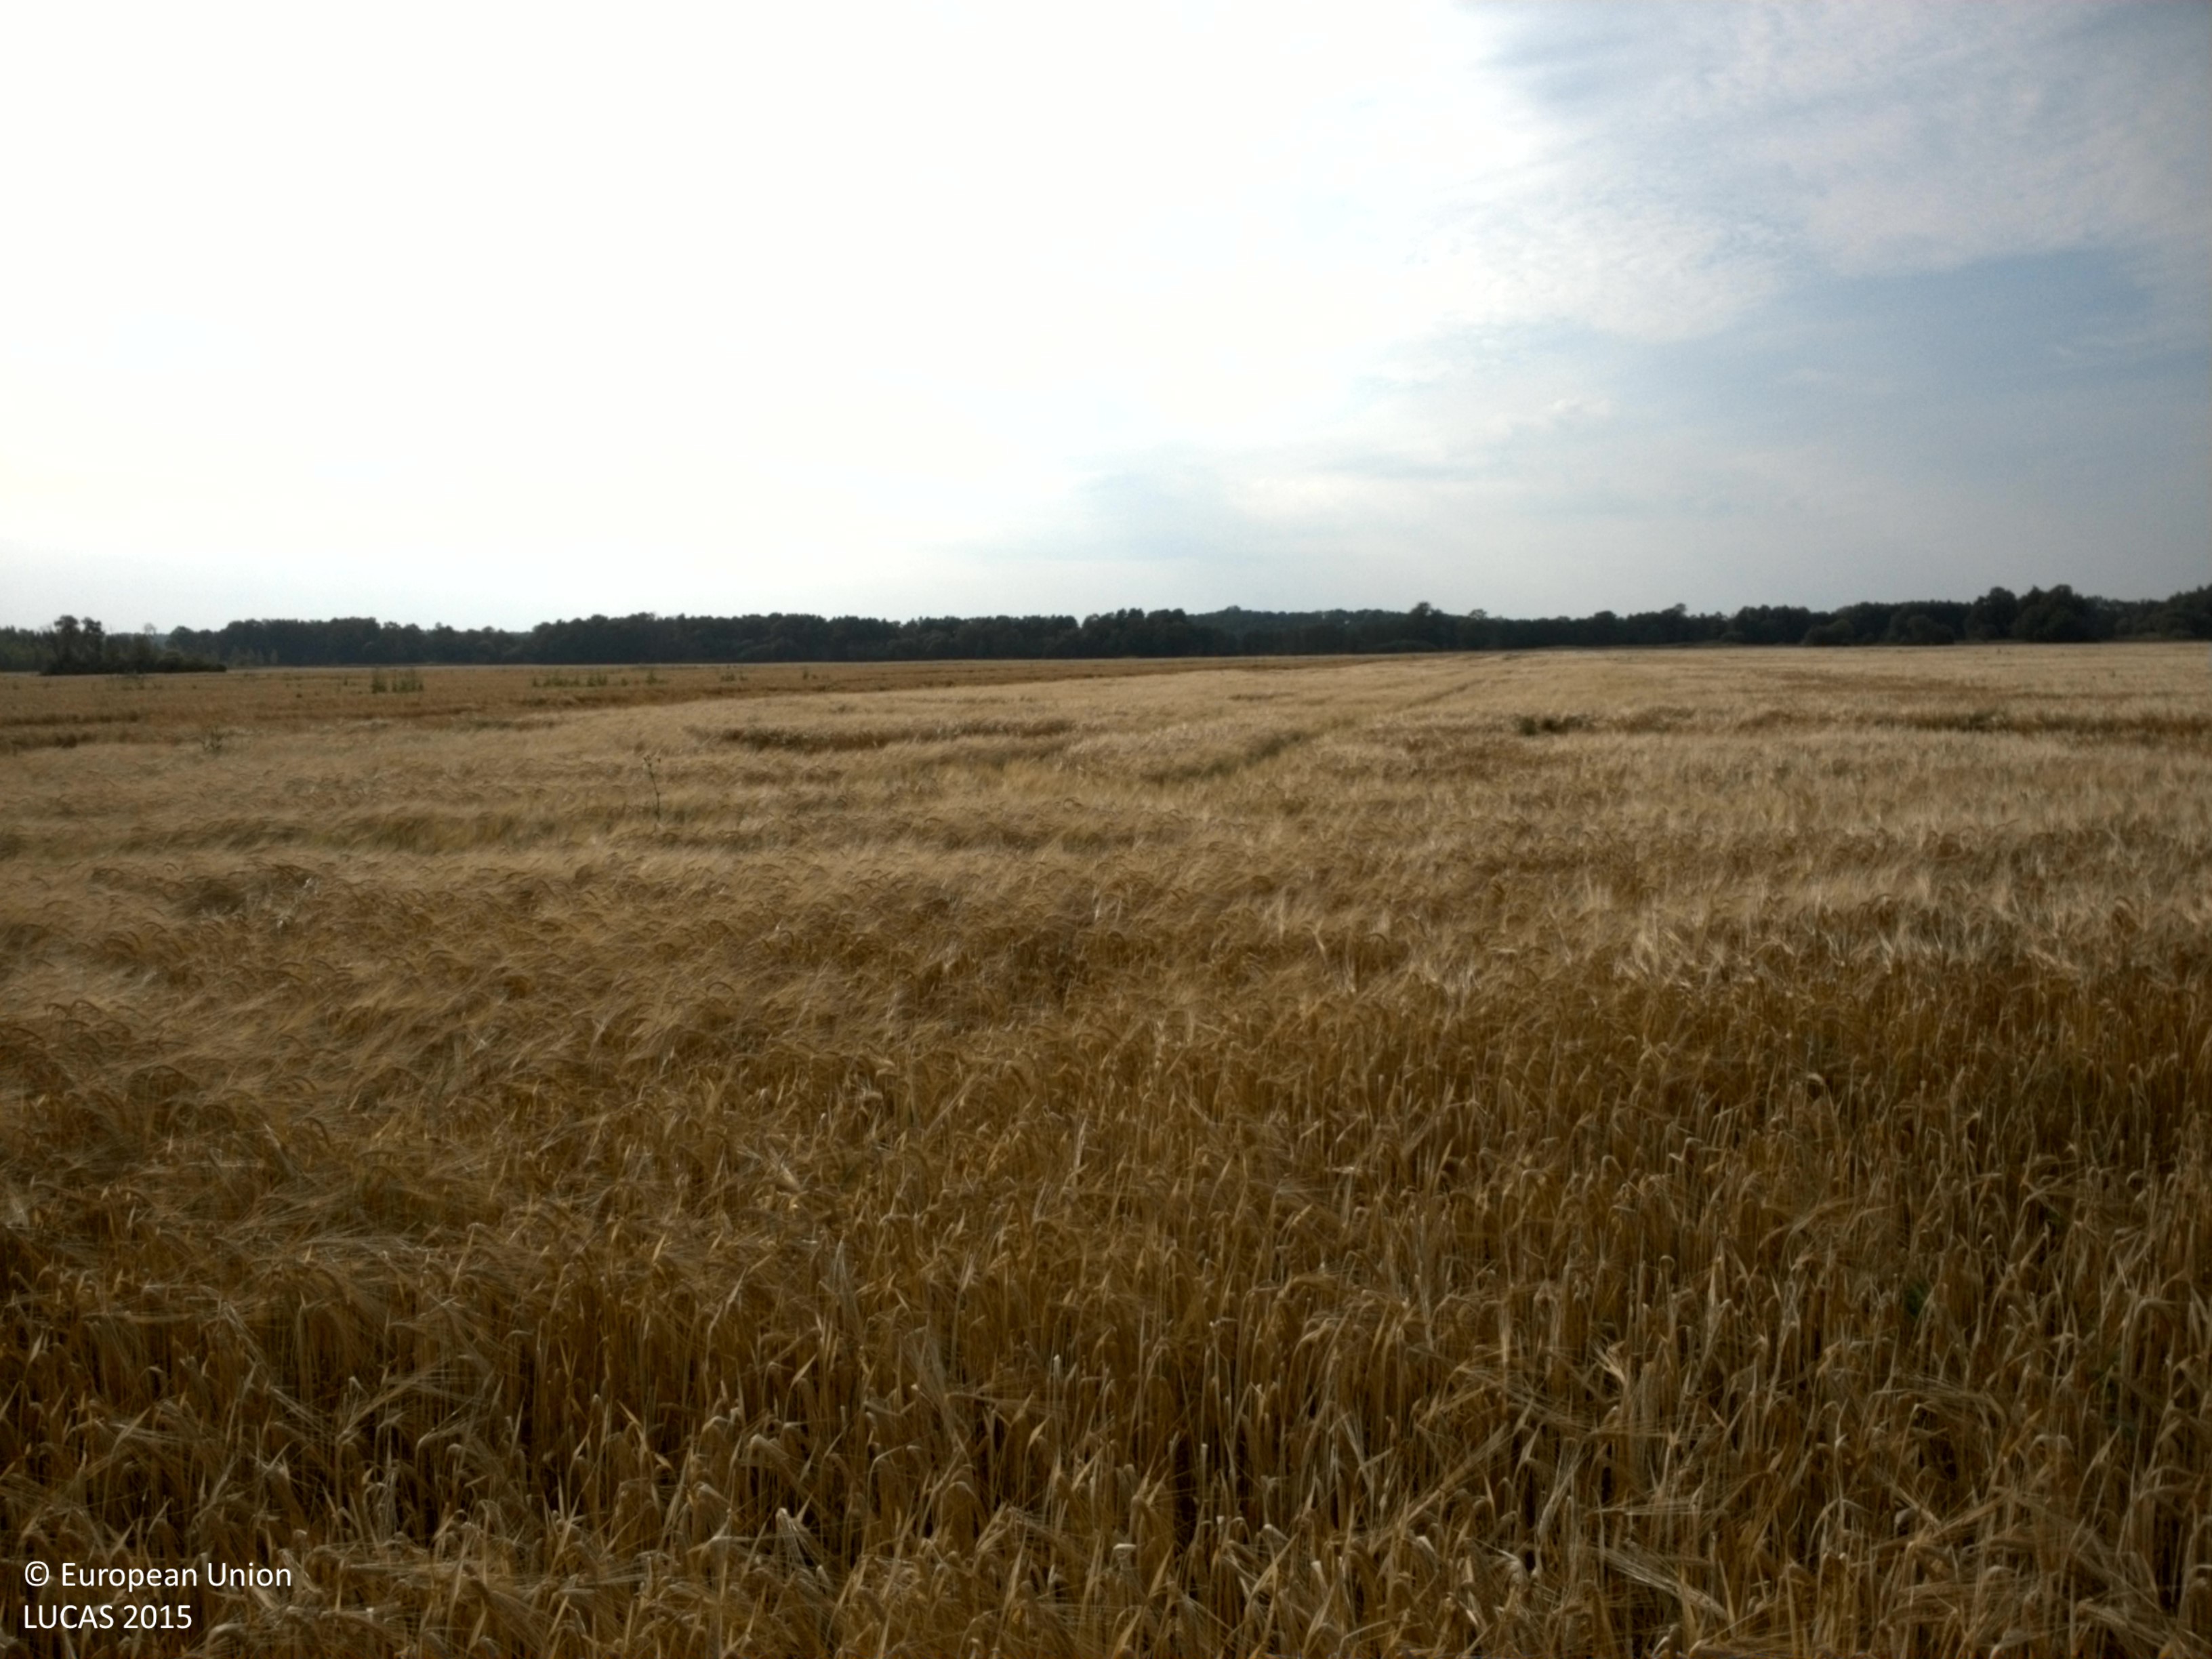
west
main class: Cropland
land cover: Barley
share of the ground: > 75 %
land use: Agriculture (excluding fallow land and kitchen gardens)
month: August
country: SE
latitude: 60.0486
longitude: 17.5889
